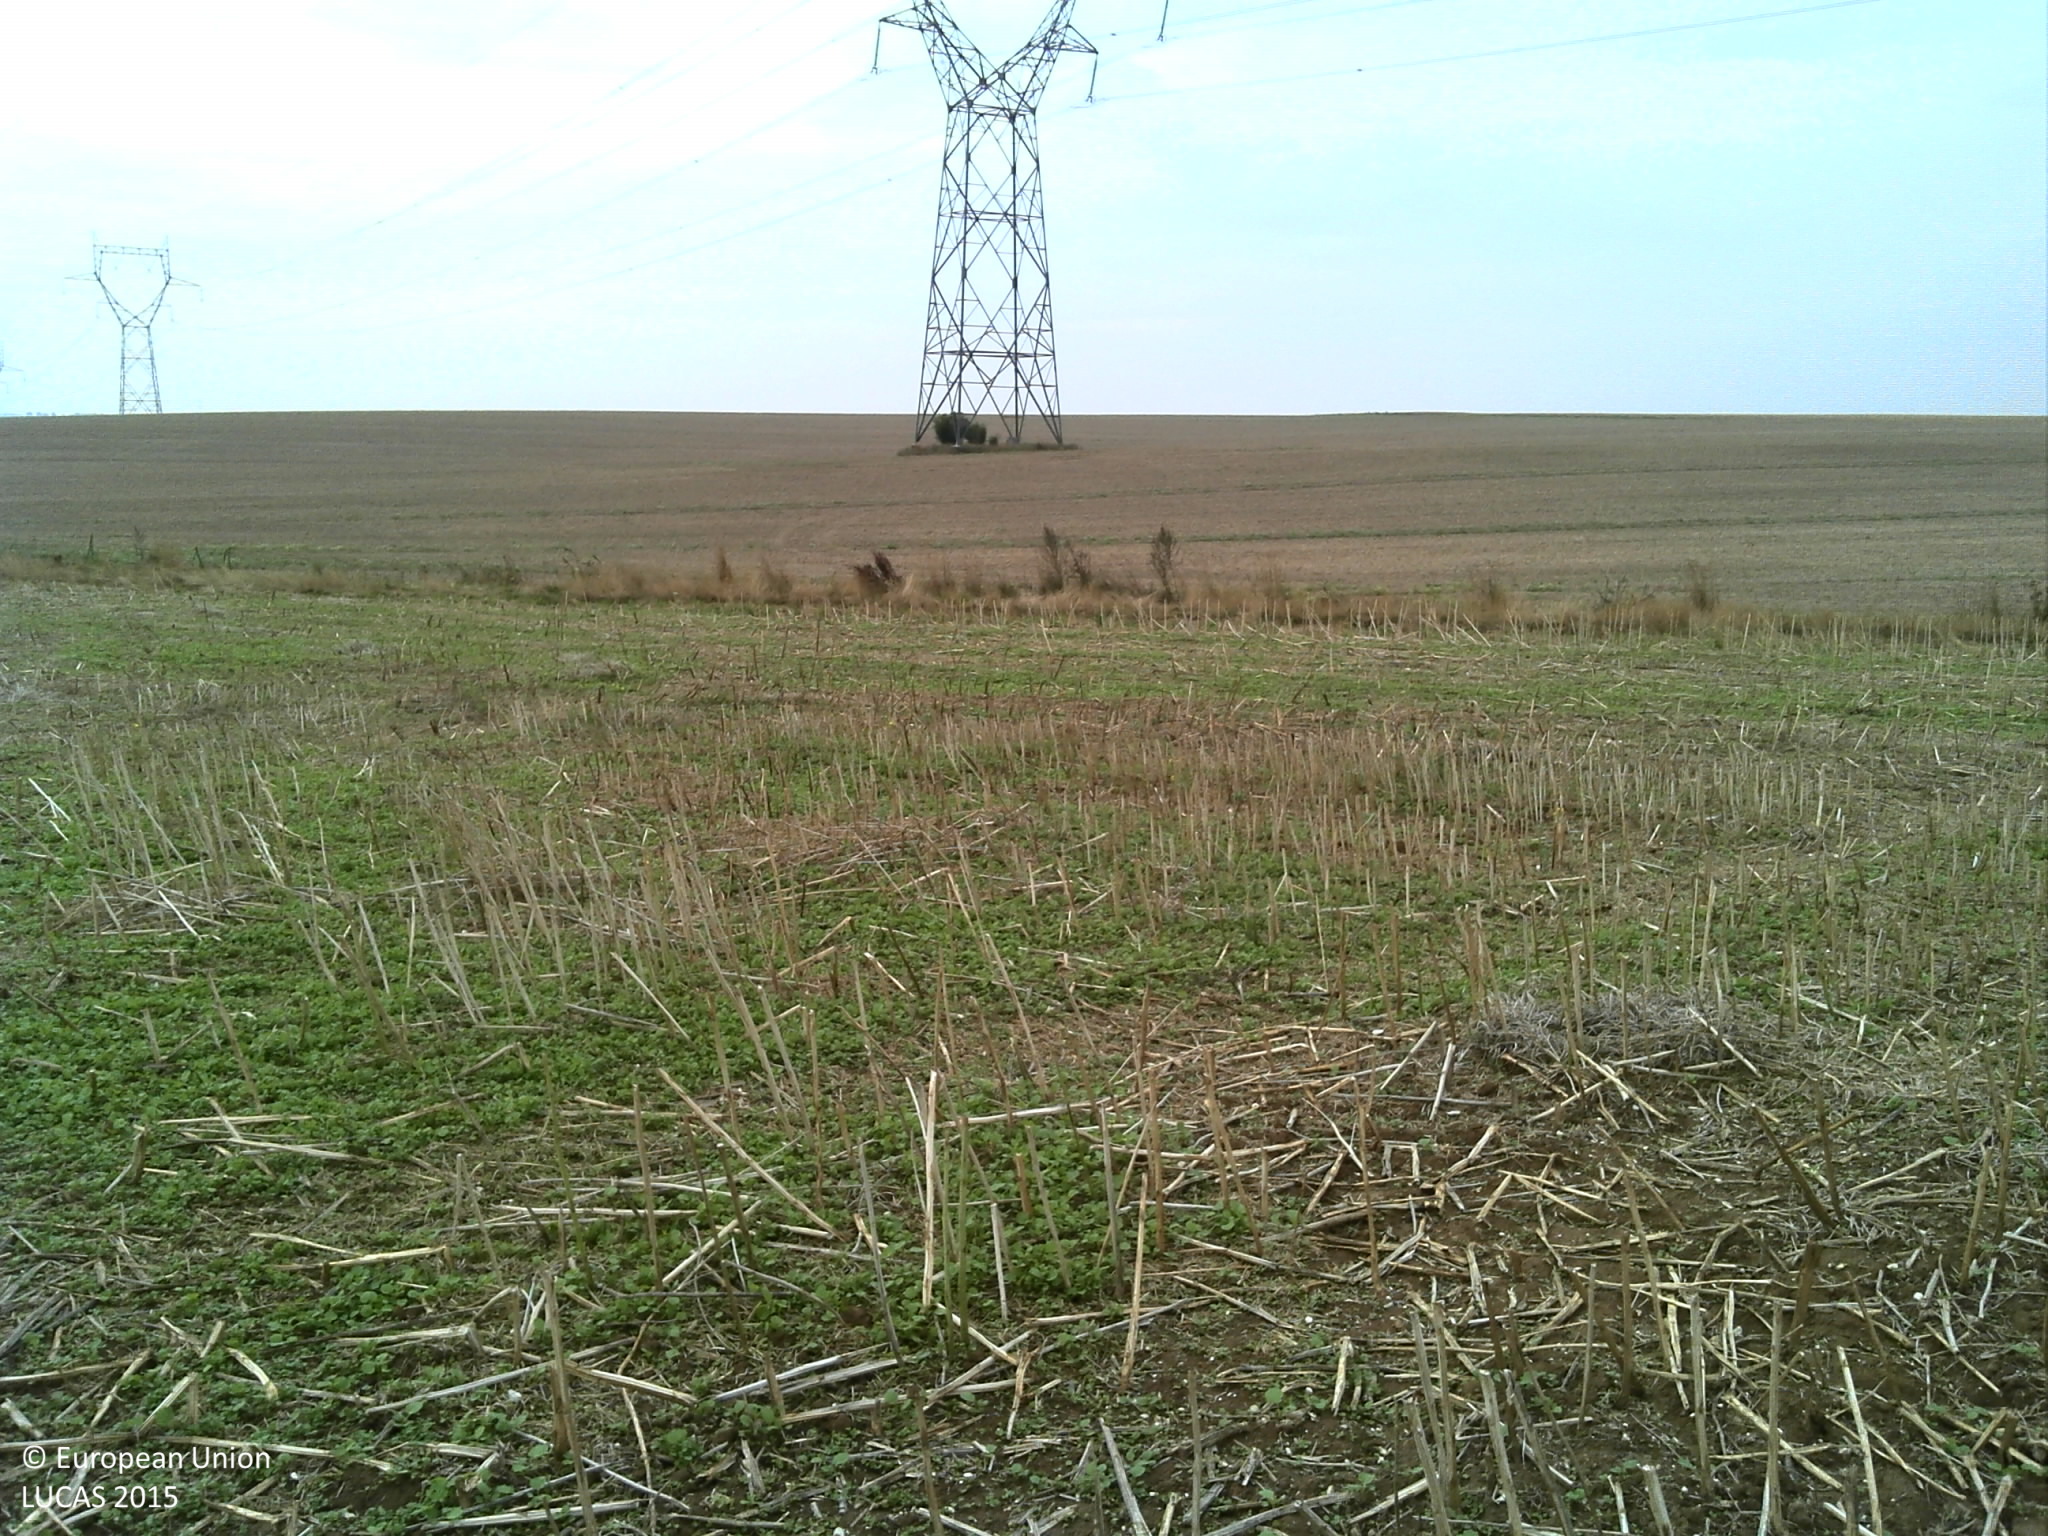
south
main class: Cropland
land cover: Rape and turnip rape
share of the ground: 25 - 50 %
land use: Agriculture (excluding fallow land and kitchen gardens)
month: August
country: FR
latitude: 50.0949
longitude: 2.7057
